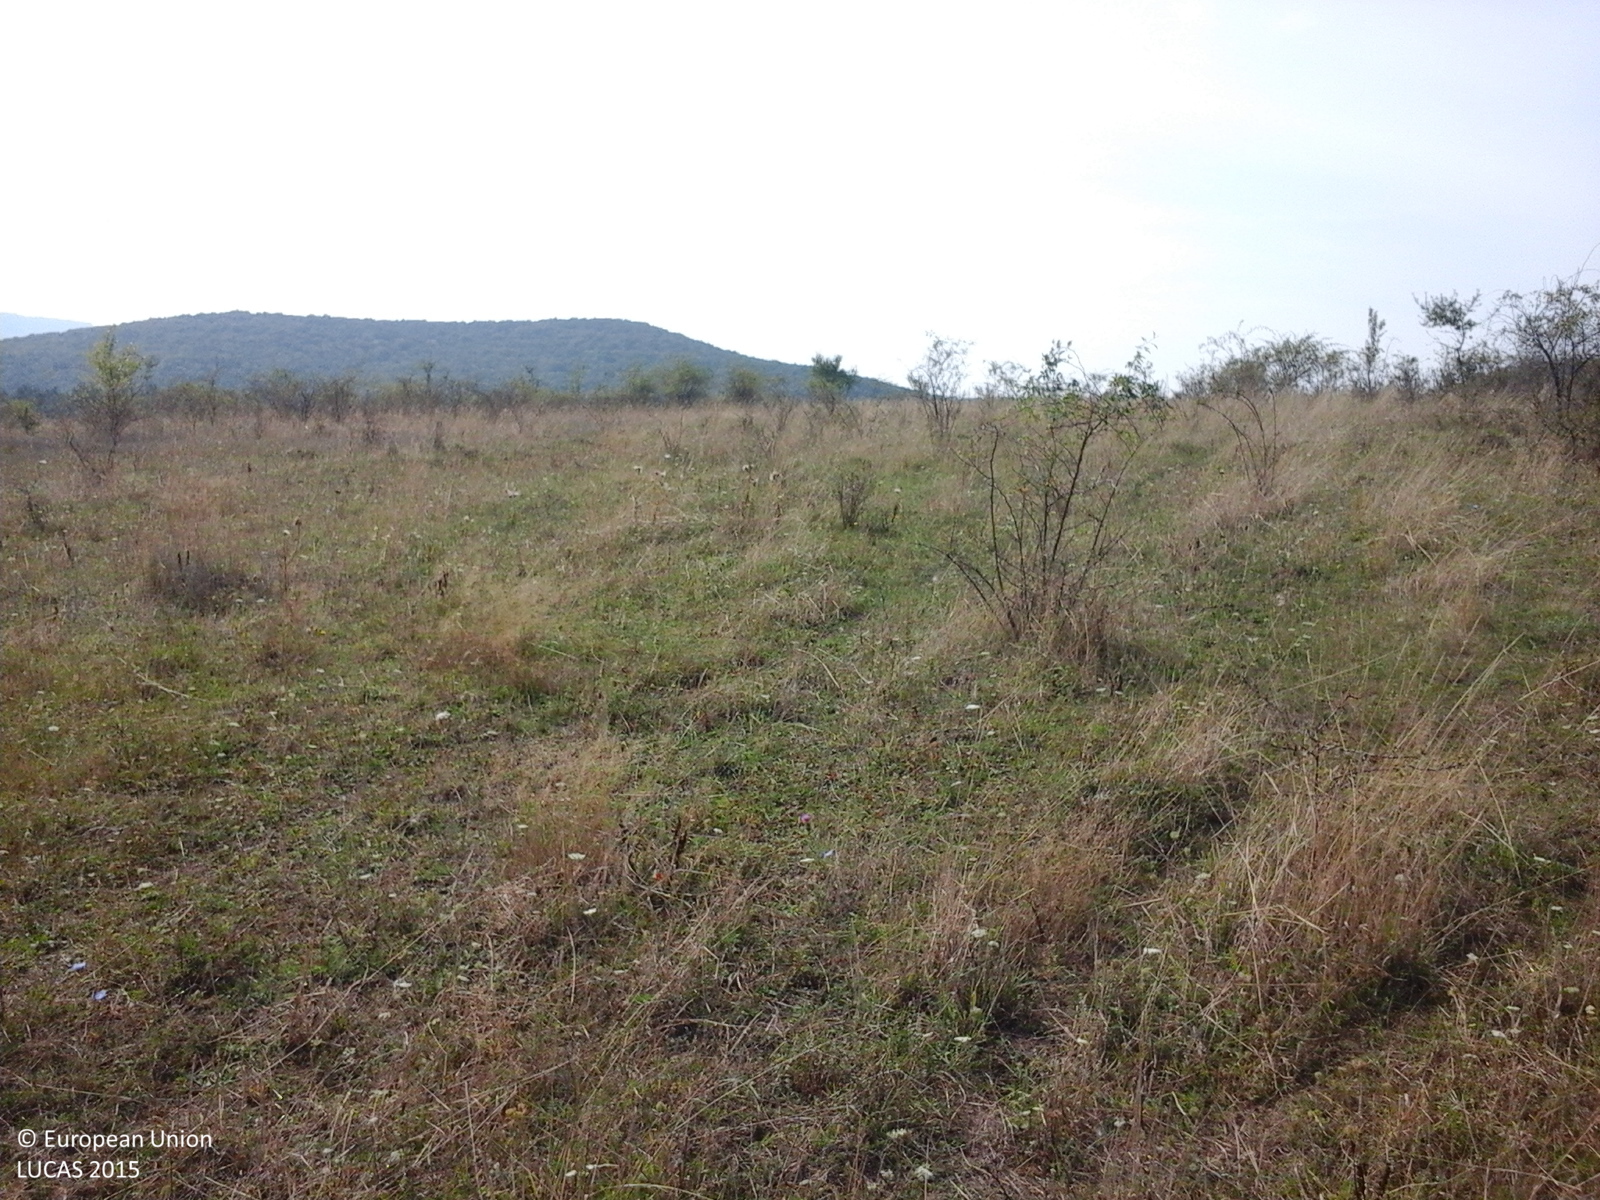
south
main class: Grassland
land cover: Spontaneously vegetated surfaces
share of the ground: > 75 %
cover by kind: herbaceous plants 100 %
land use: Fallow land
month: September
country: RO
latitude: 47.1545
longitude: 23.6192
